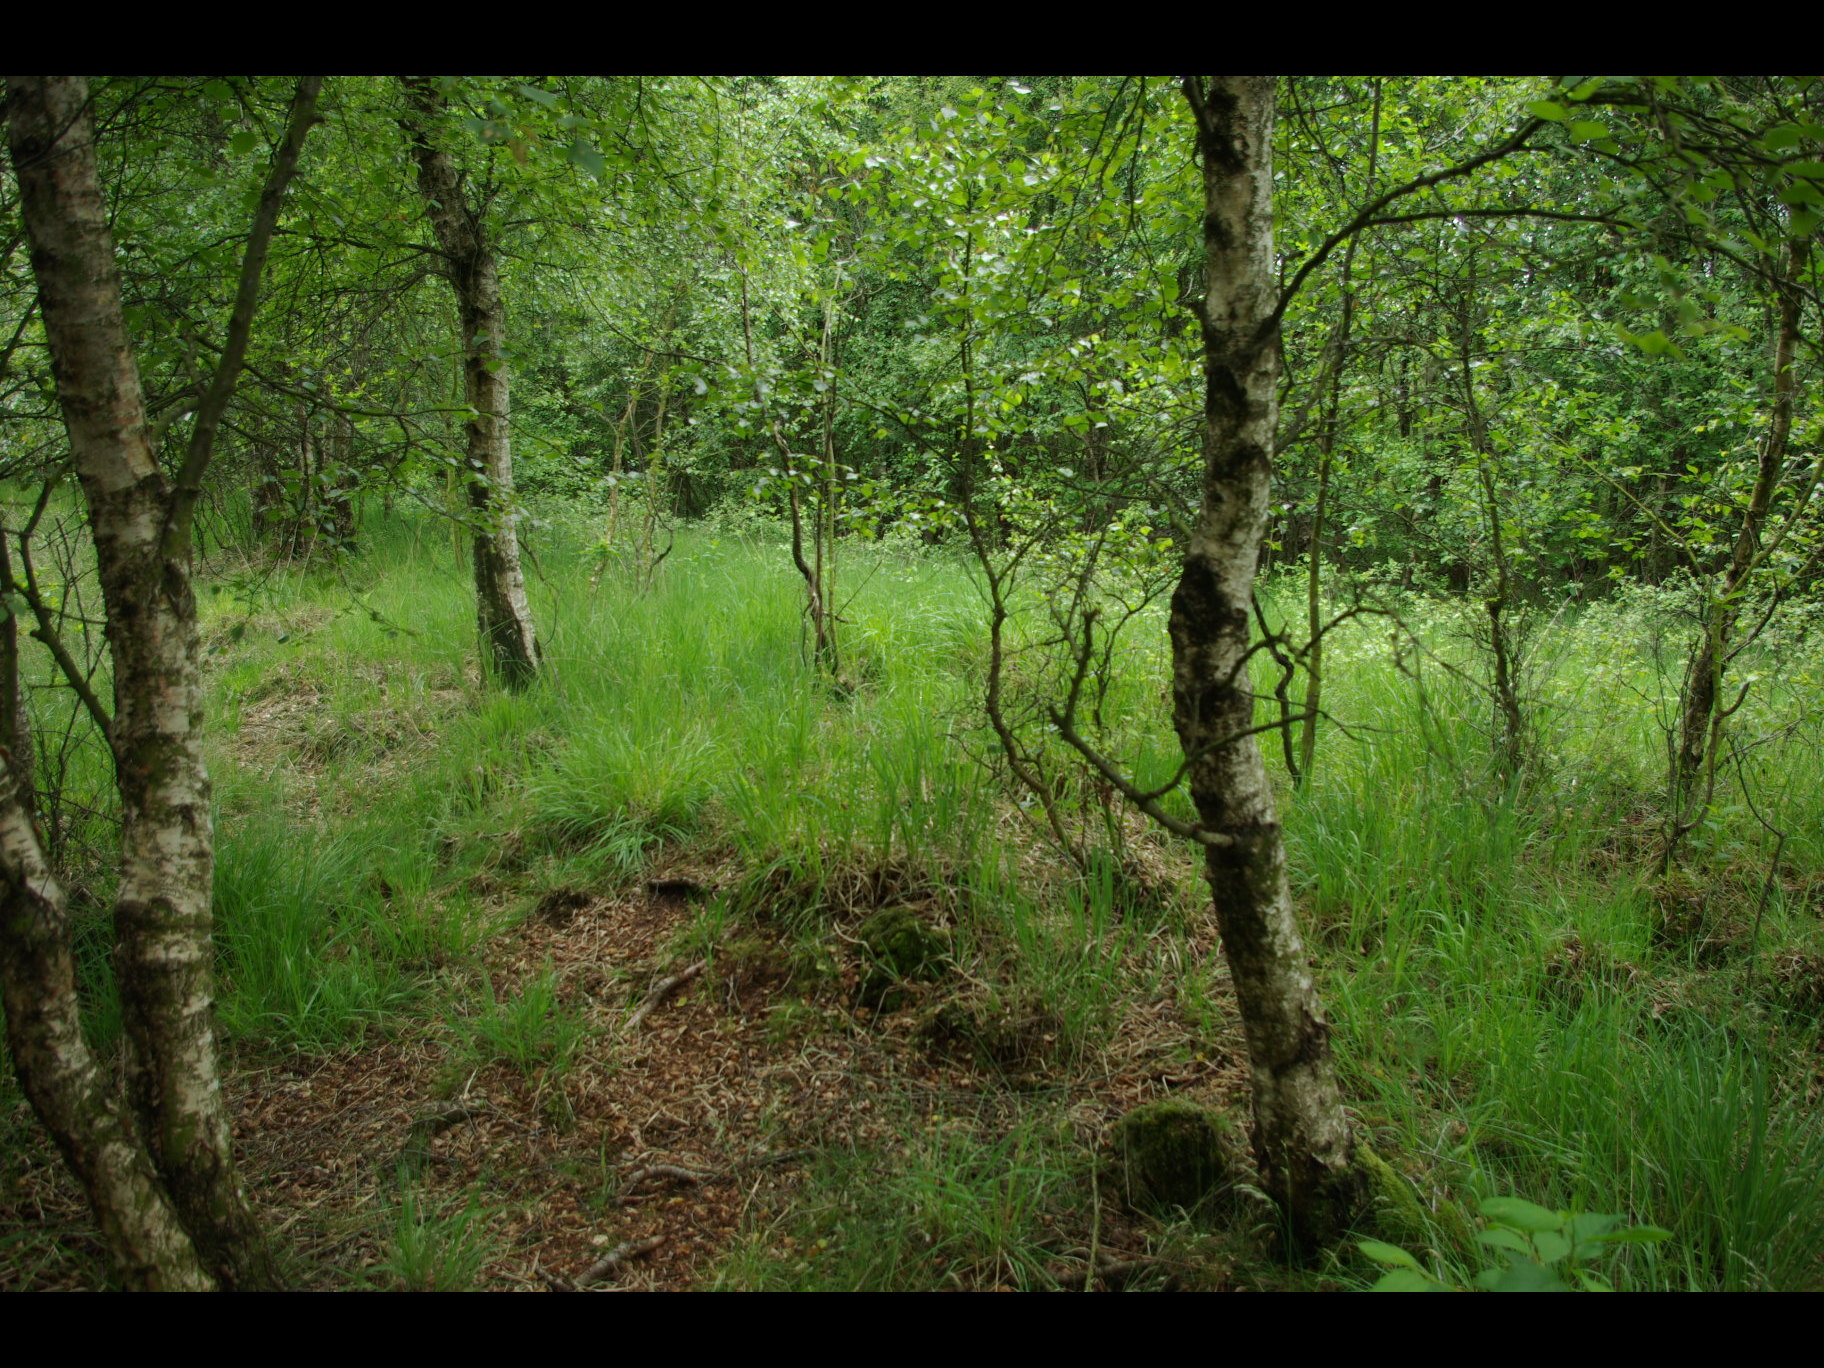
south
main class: Woodland
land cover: Broadleaved woodland
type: mire and swamp forests
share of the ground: > 75 %
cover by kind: broadleaved forest trees 70 %, herbaceous plants 20 %, lichens and mosses 10 %
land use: Semi-natural and natural areas not in use
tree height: < 5 m
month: June
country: DE
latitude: 54.1567
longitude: 9.9541
